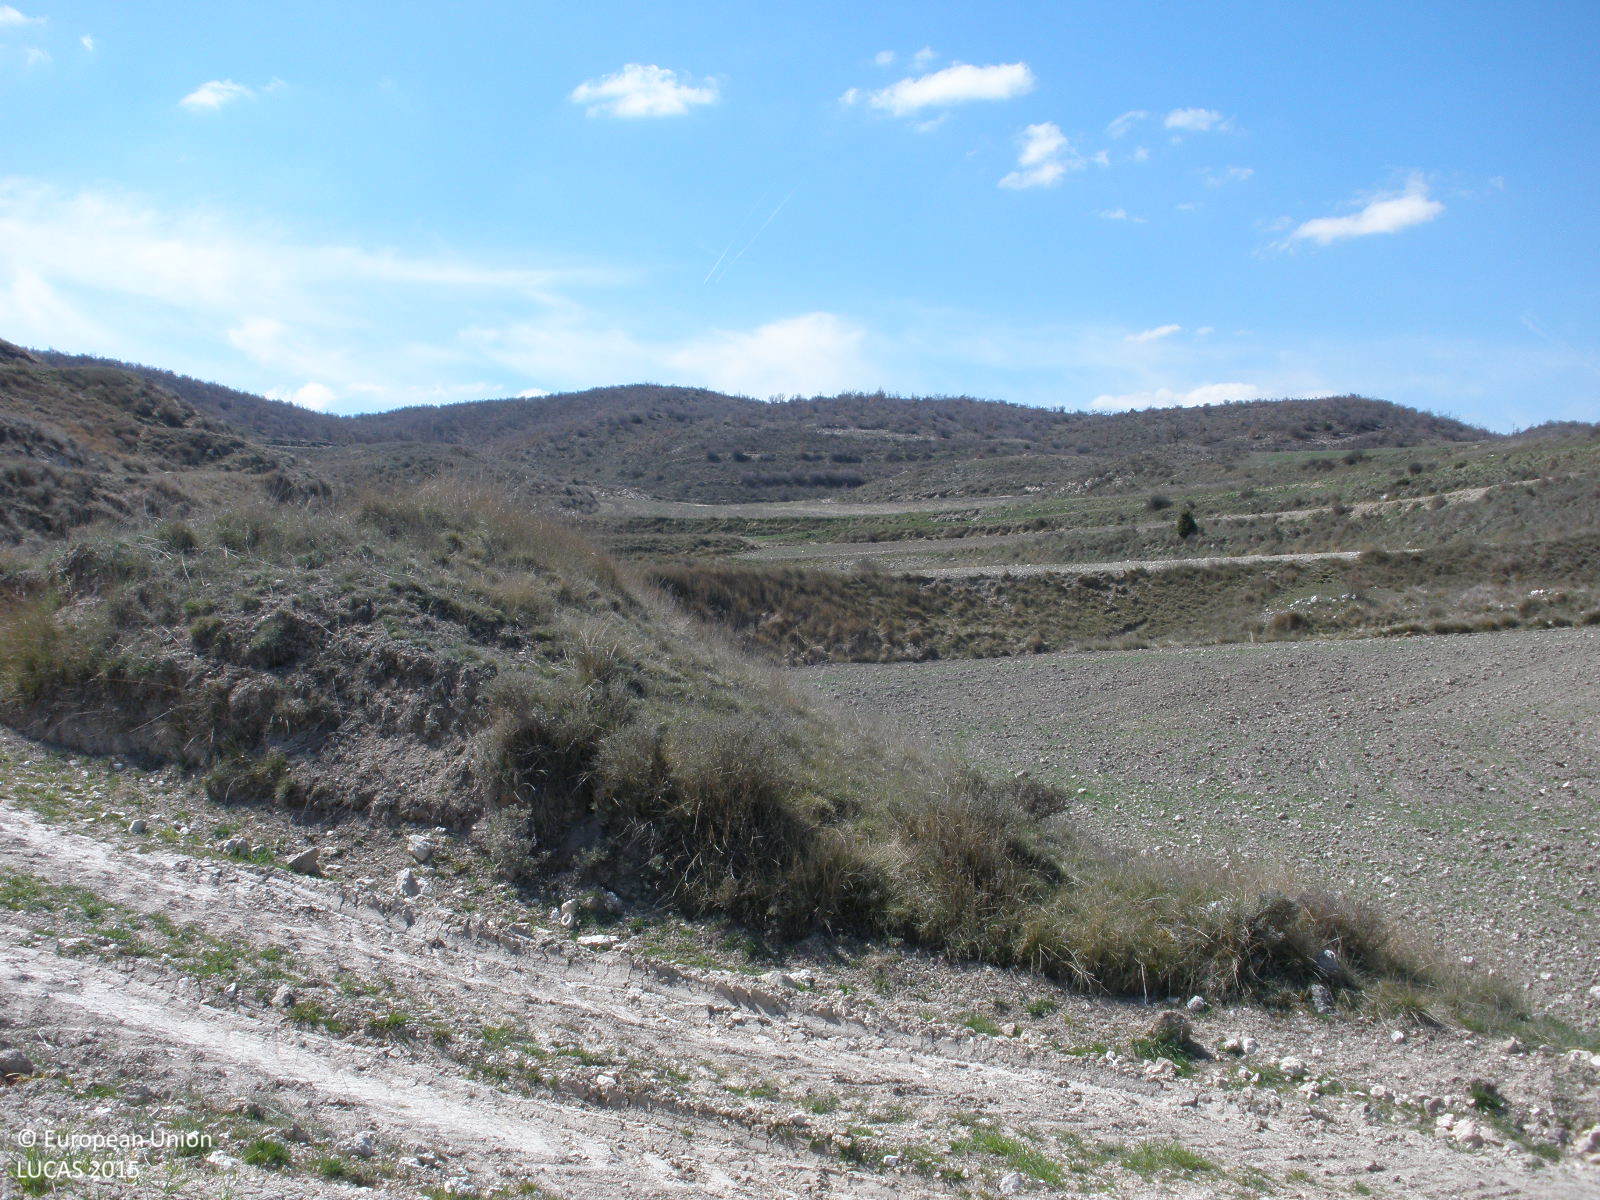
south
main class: Cropland
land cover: Barley
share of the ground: 50 - 75 %
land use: Agriculture (excluding fallow land and kitchen gardens)
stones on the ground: 10 - 25 %
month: April
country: ES
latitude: 40.8898
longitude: -1.1374
